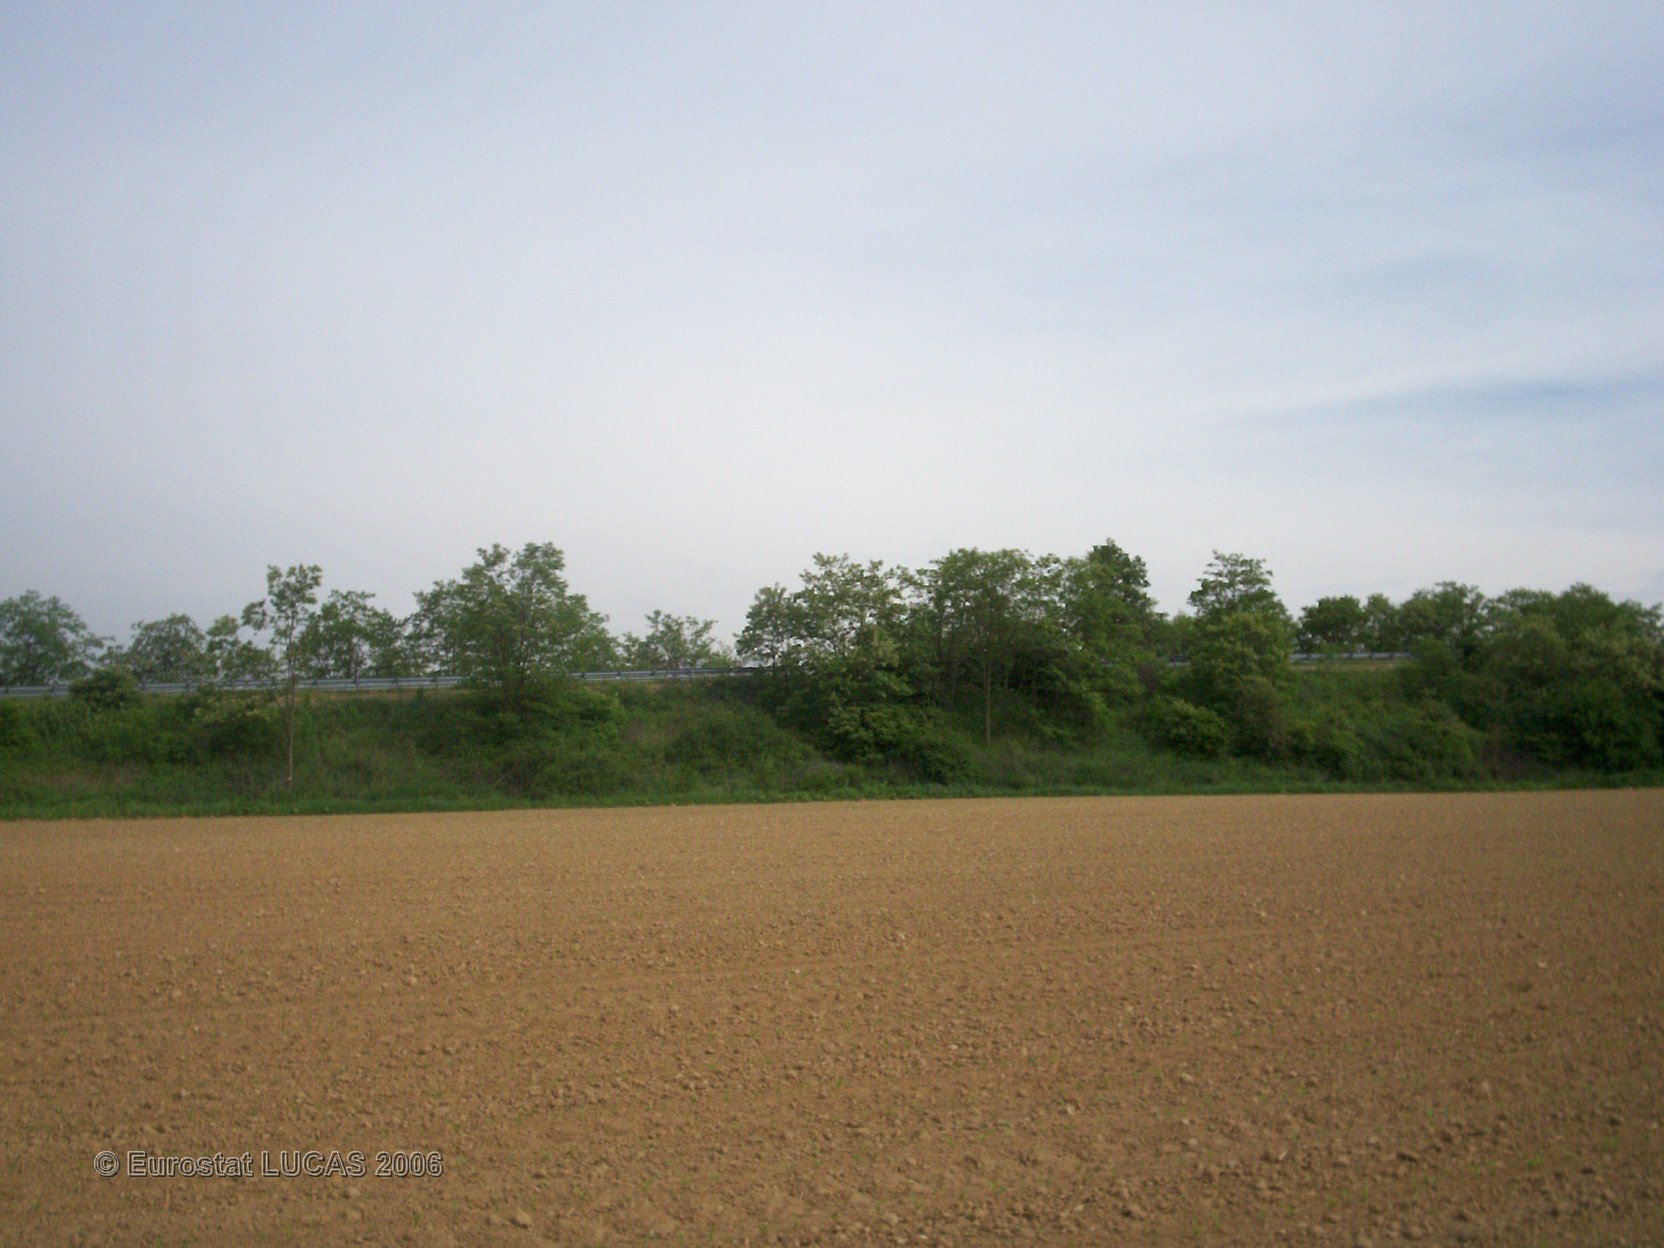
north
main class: Cropland
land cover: Maize
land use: Agriculture (excluding fallow land and kitchen gardens)
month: May
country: FR
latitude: 45.8681
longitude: 4.8893
